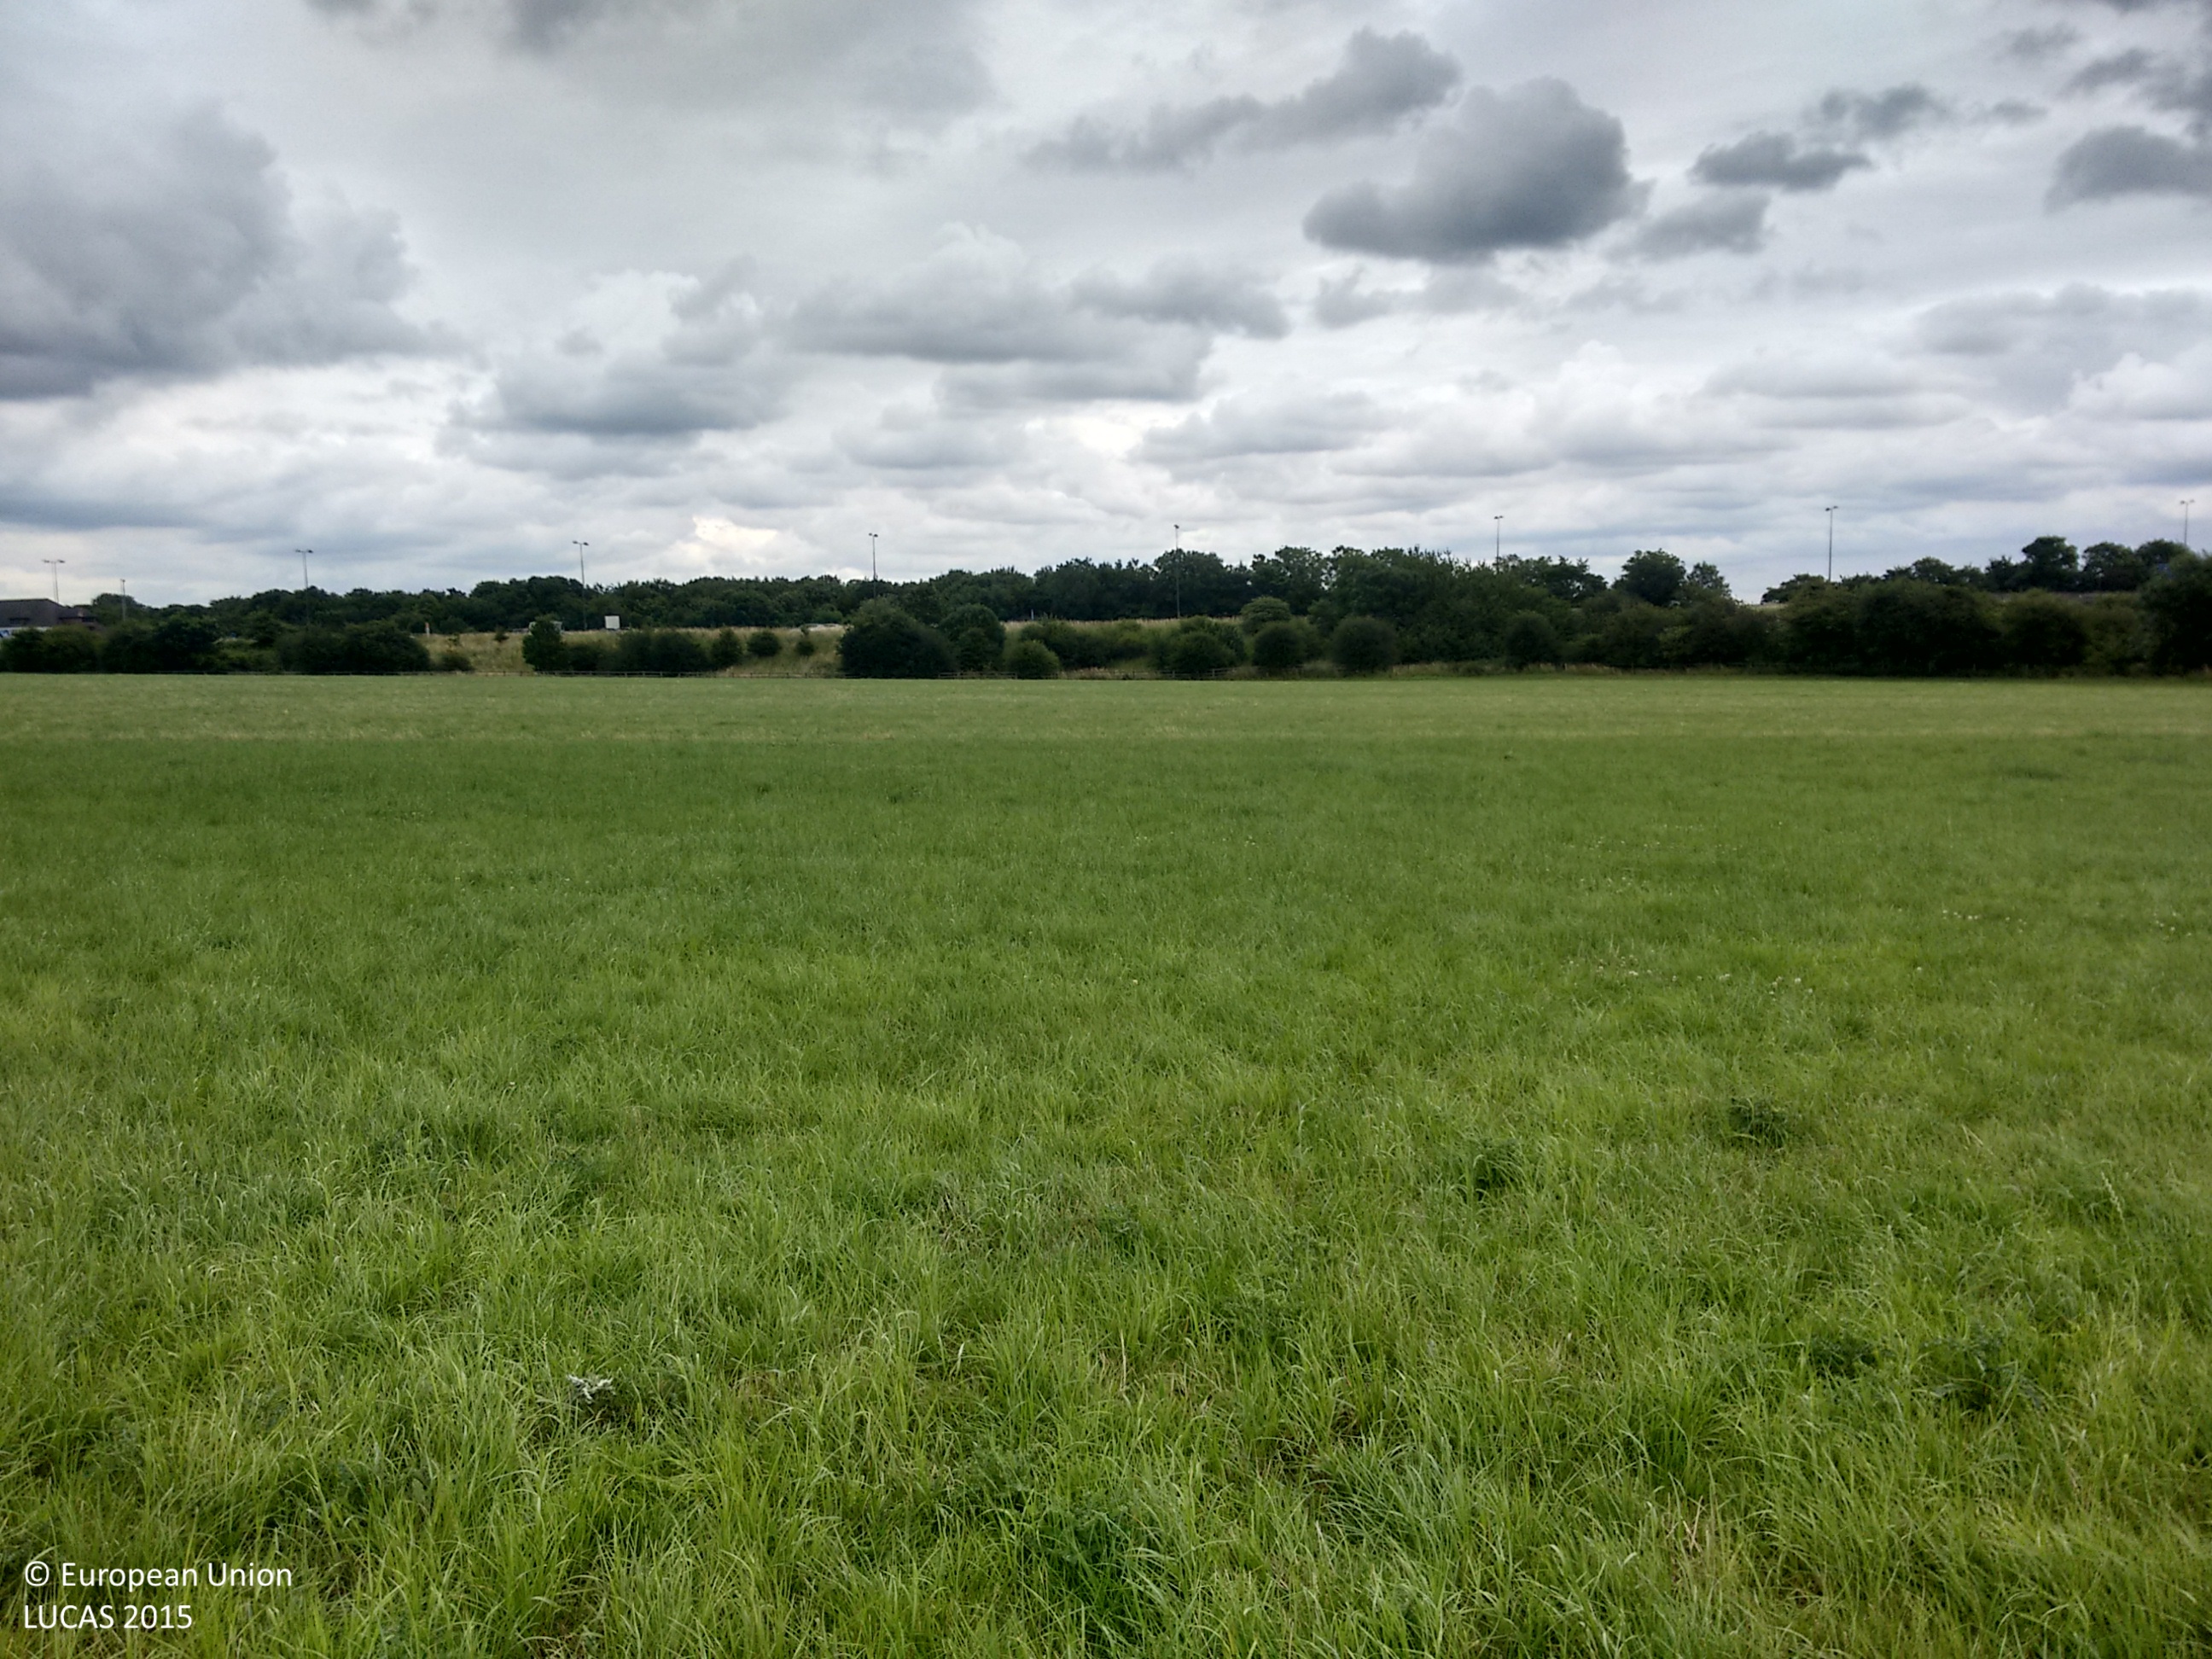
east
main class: Grassland
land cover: Grassland without tree/shrub cover
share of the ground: > 75 %
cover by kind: herbaceous plants 100 %
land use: Agriculture (excluding fallow land and kitchen gardens)
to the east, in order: Grassland without tree/shrub cover; Fences; Grassland with sparse tree/shrub cover; Paved roads, cycling and walking lanes; Grass margins; Broadleaved woodland
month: July
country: GB
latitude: 52.9071
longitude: -1.3035
